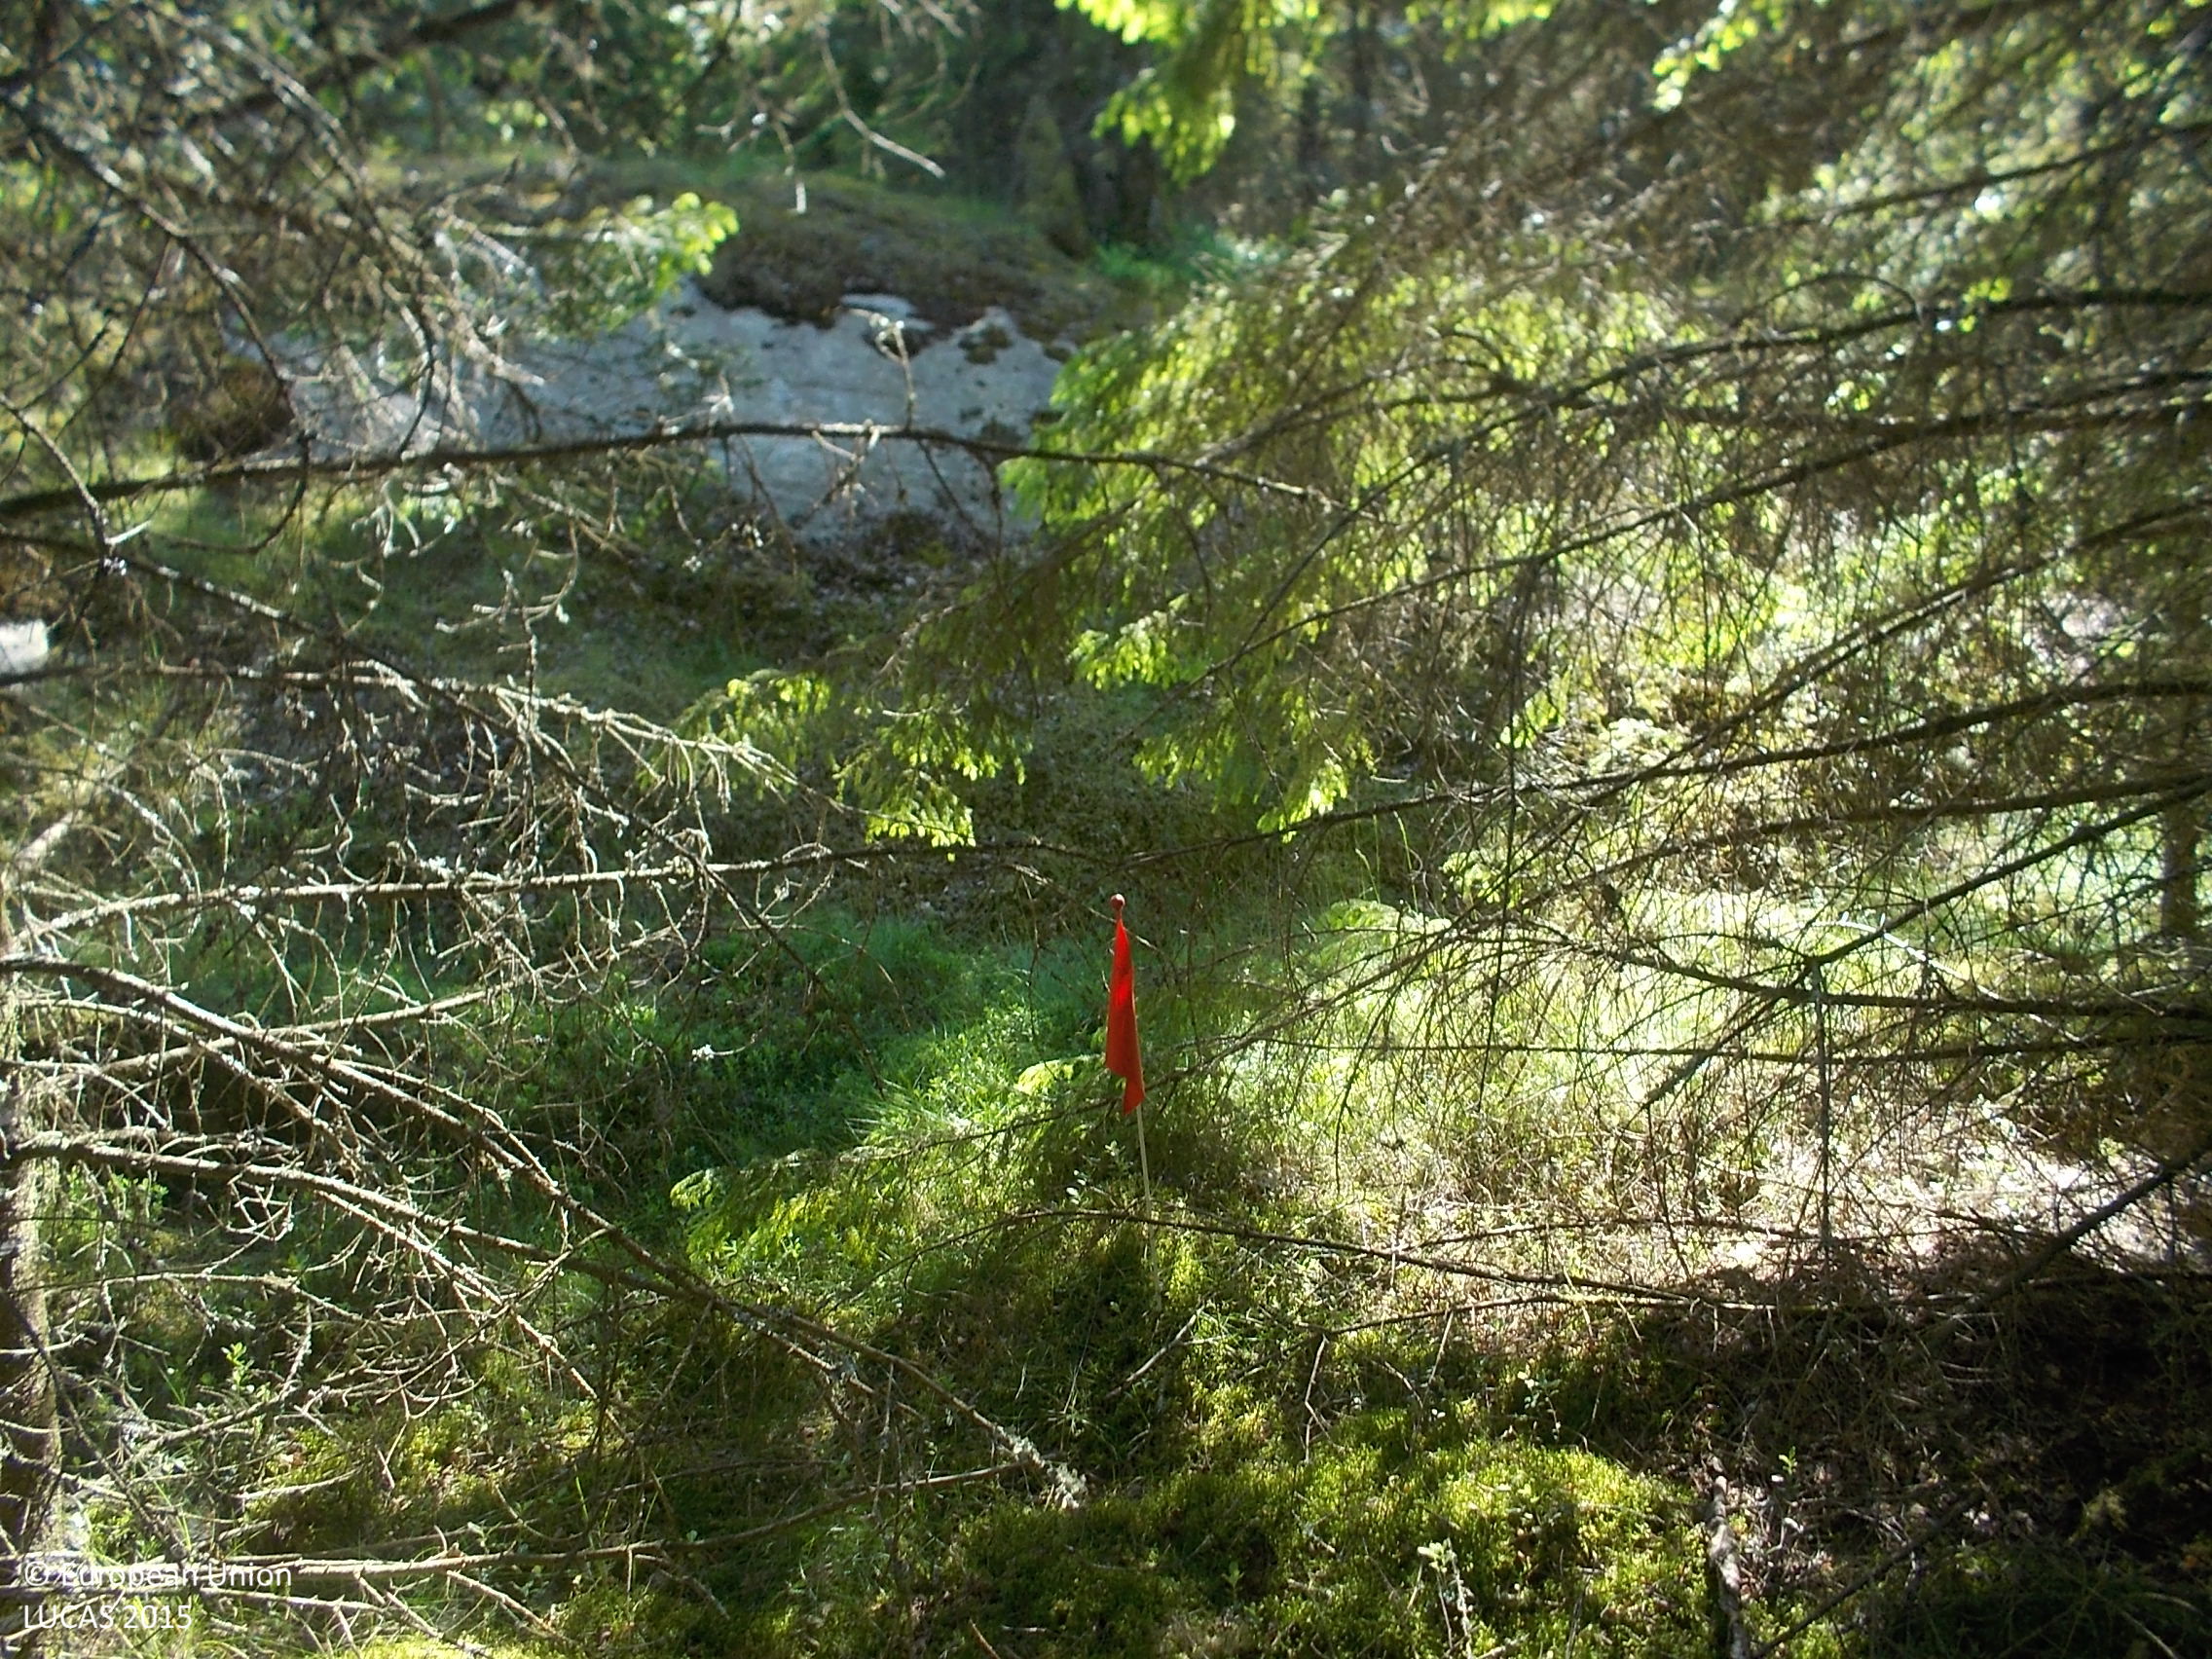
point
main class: Woodland
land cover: Spruce dominated coniferous woodland
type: boreal forest
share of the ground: > 75 %
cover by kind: coniferous forest trees 75 %, lichens and mosses 15 %, unconsolidated bare surface 10 %
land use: Forestry
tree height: > 5 m
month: July
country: SE
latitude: 57.2995
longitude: 13.1991
